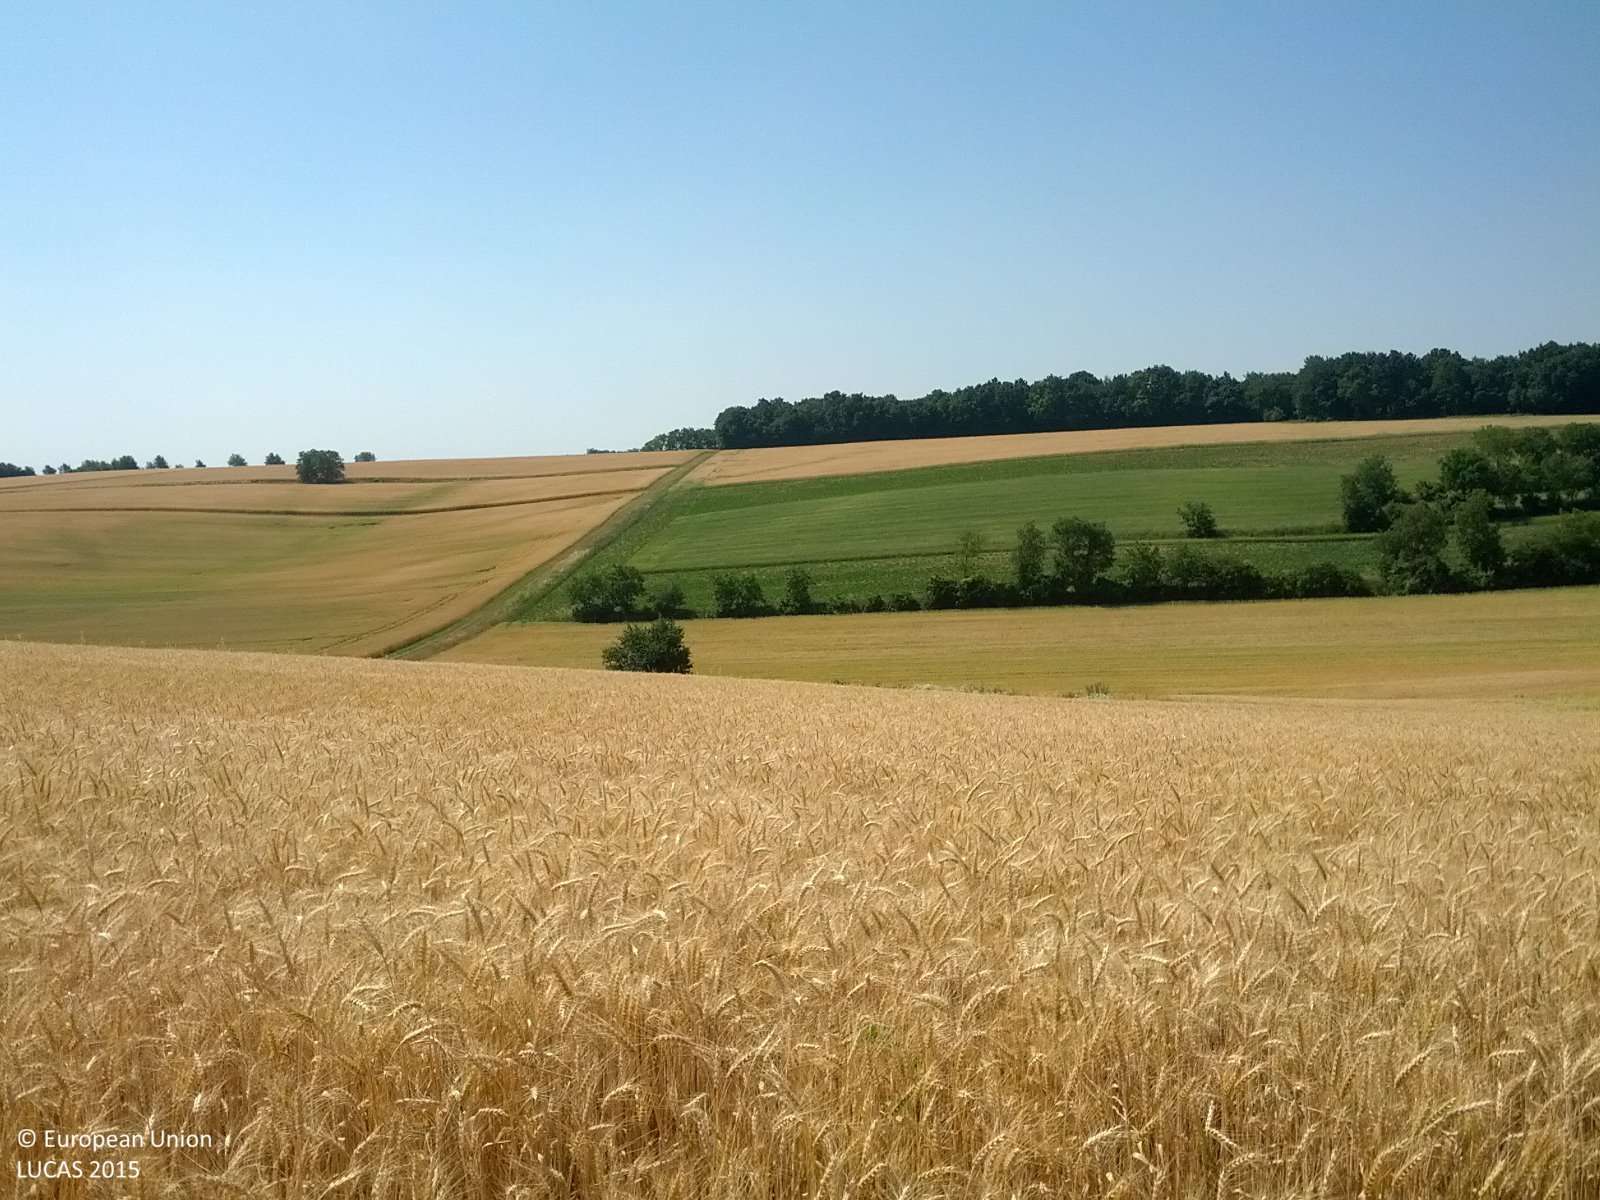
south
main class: Cropland
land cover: Common wheat
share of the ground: > 75 %
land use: Agriculture (excluding fallow land and kitchen gardens)
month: July
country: AT
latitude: 48.6270
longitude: 16.5052
